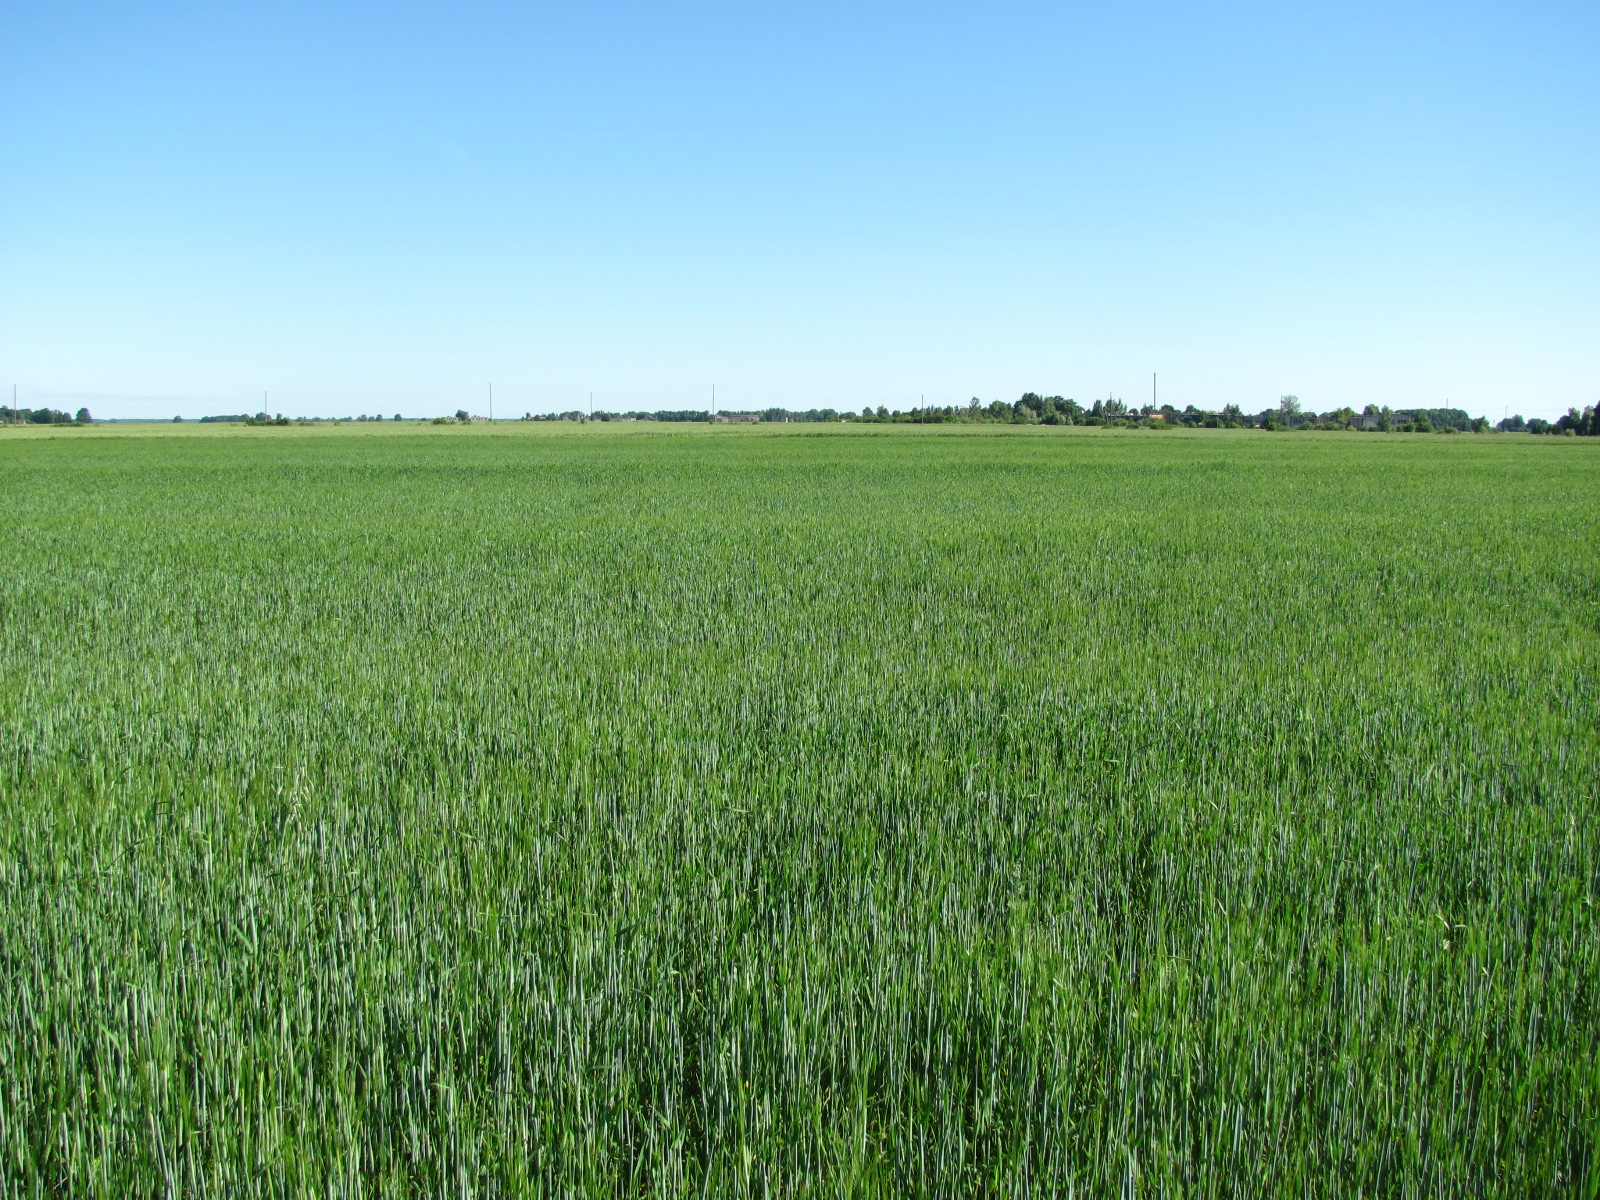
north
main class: Cropland
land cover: Barley
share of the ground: > 75 %
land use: Agriculture (excluding fallow land and kitchen gardens)
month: July
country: LV
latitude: 56.5105
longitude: 23.8455
